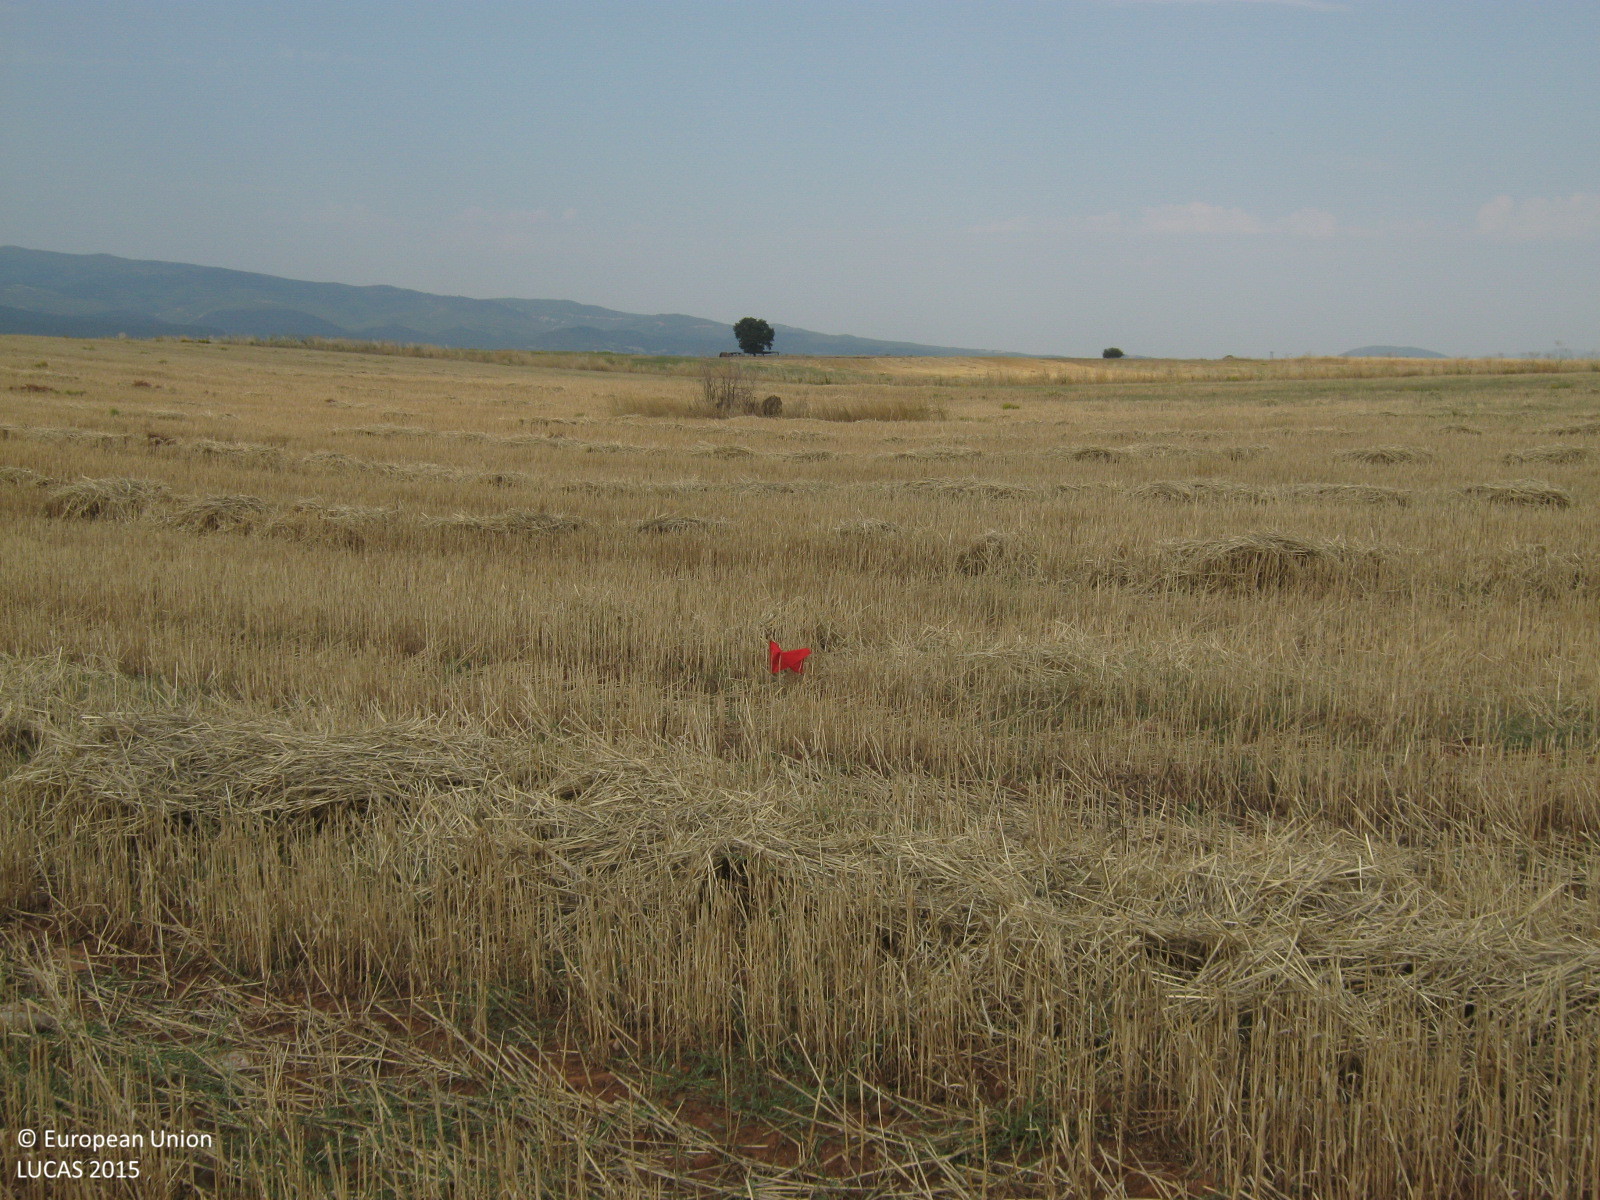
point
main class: Cropland
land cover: Durum wheat
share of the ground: < 10 %
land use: Agriculture (excluding fallow land and kitchen gardens)
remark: Harvested field
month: July
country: GR
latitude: 39.2019
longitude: 22.6898
